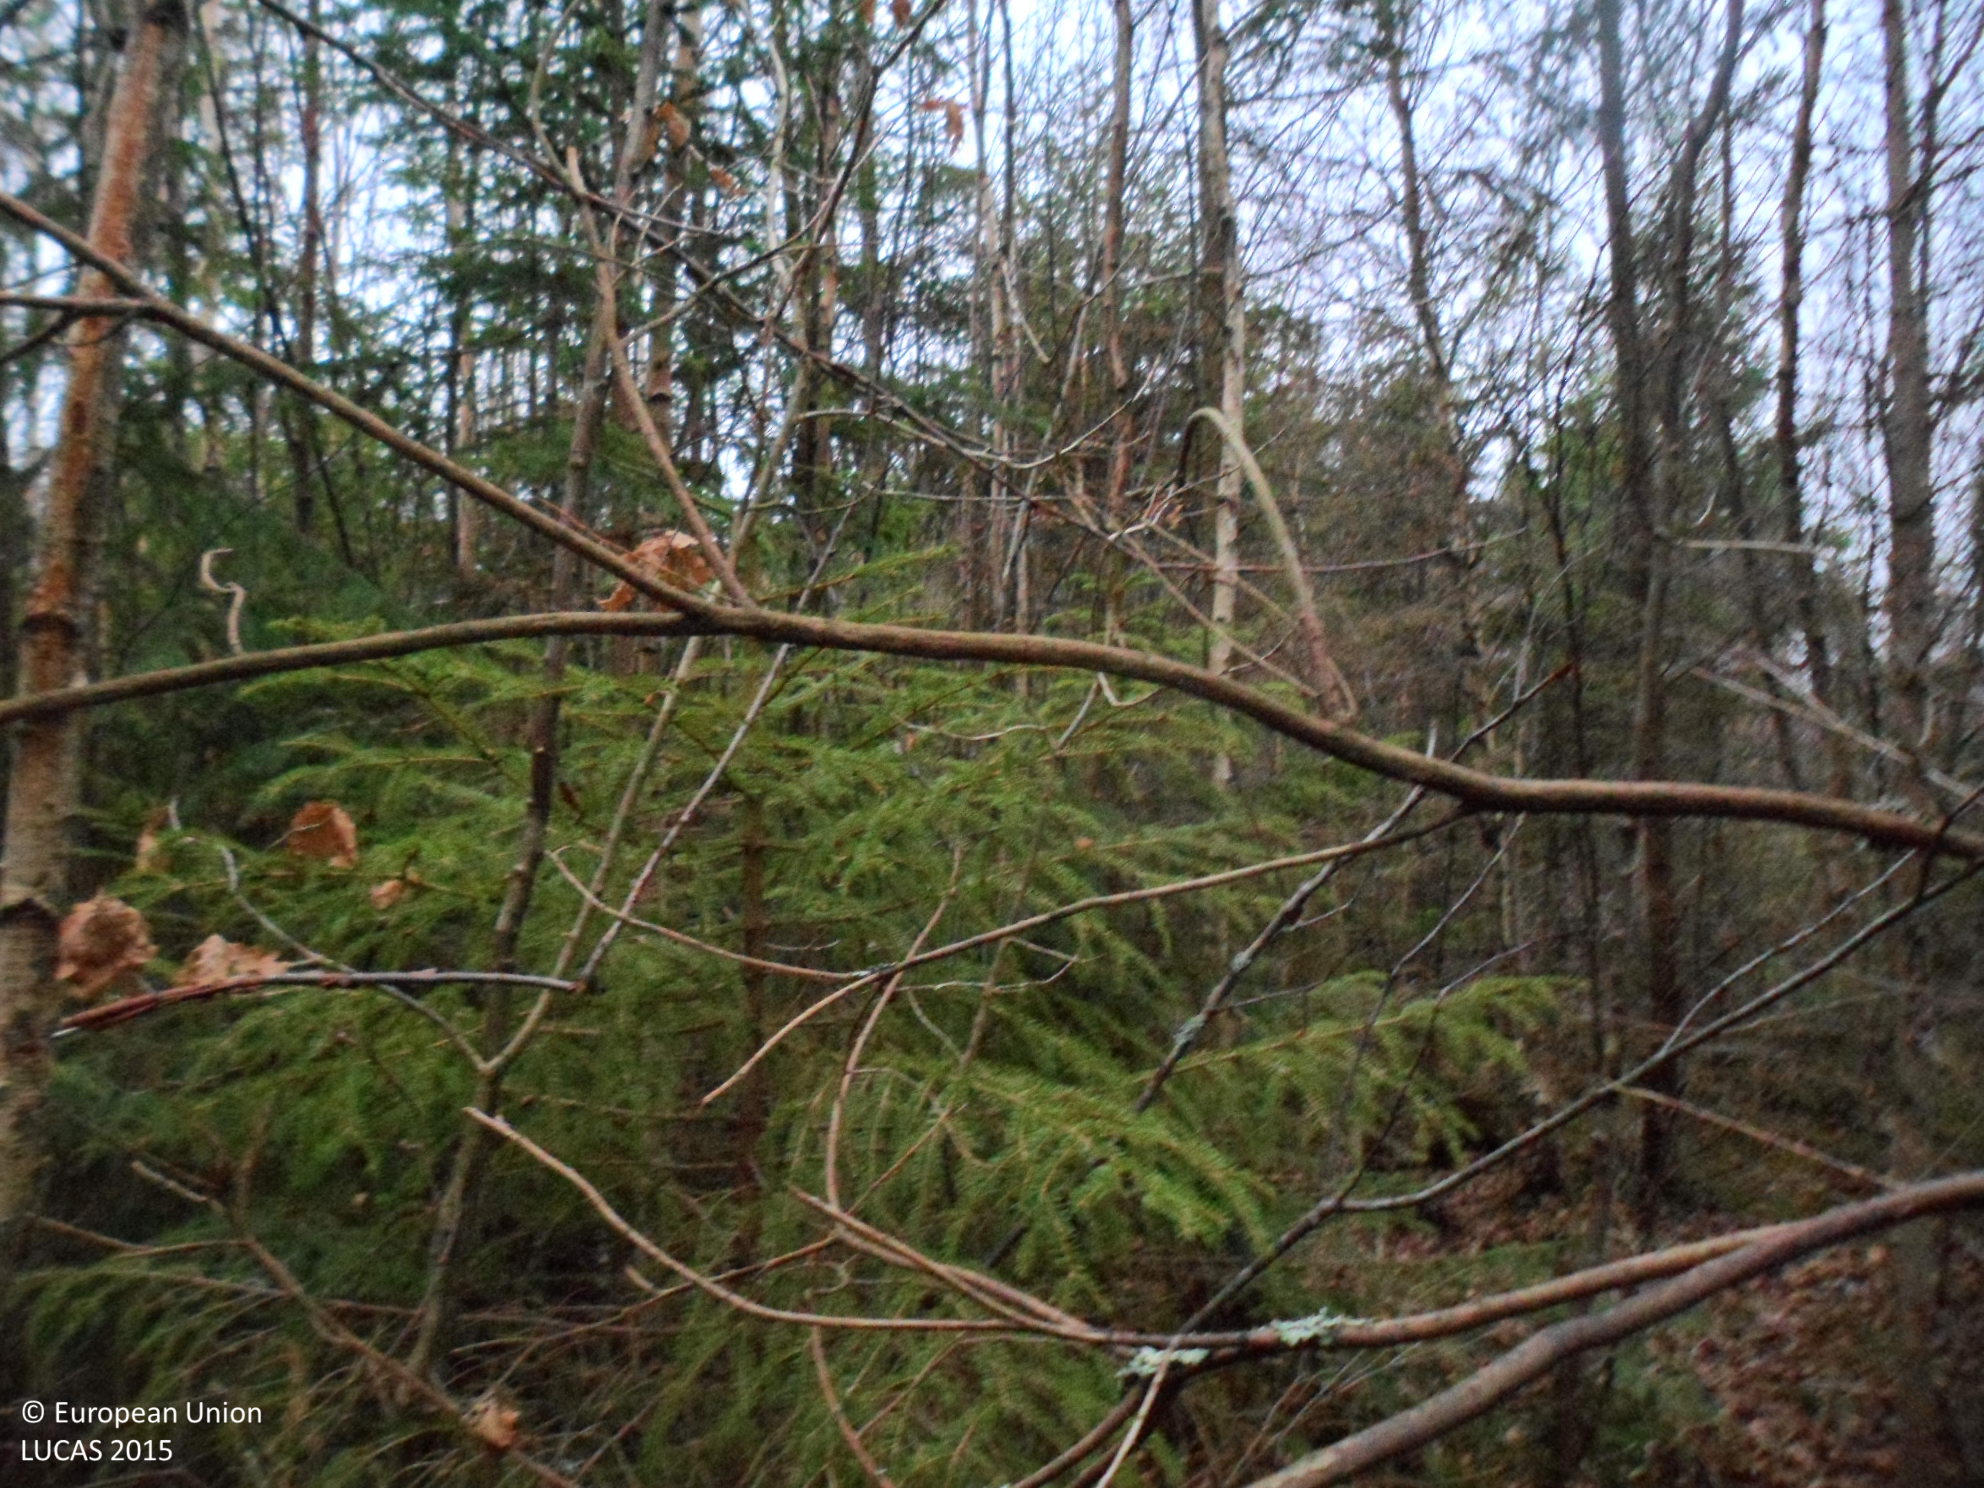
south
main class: Woodland
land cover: Spruce dominated mixed woodland
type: boreal forest
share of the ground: > 75 %
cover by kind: coniferous forest trees 45 %, broadleaved forest trees 30 %, shrubs 10 %, lichens and mosses 10 %, herbaceous plants 5 %
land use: Forestry
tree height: > 5 m
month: November
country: SE
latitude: 56.7701
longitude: 15.9716
